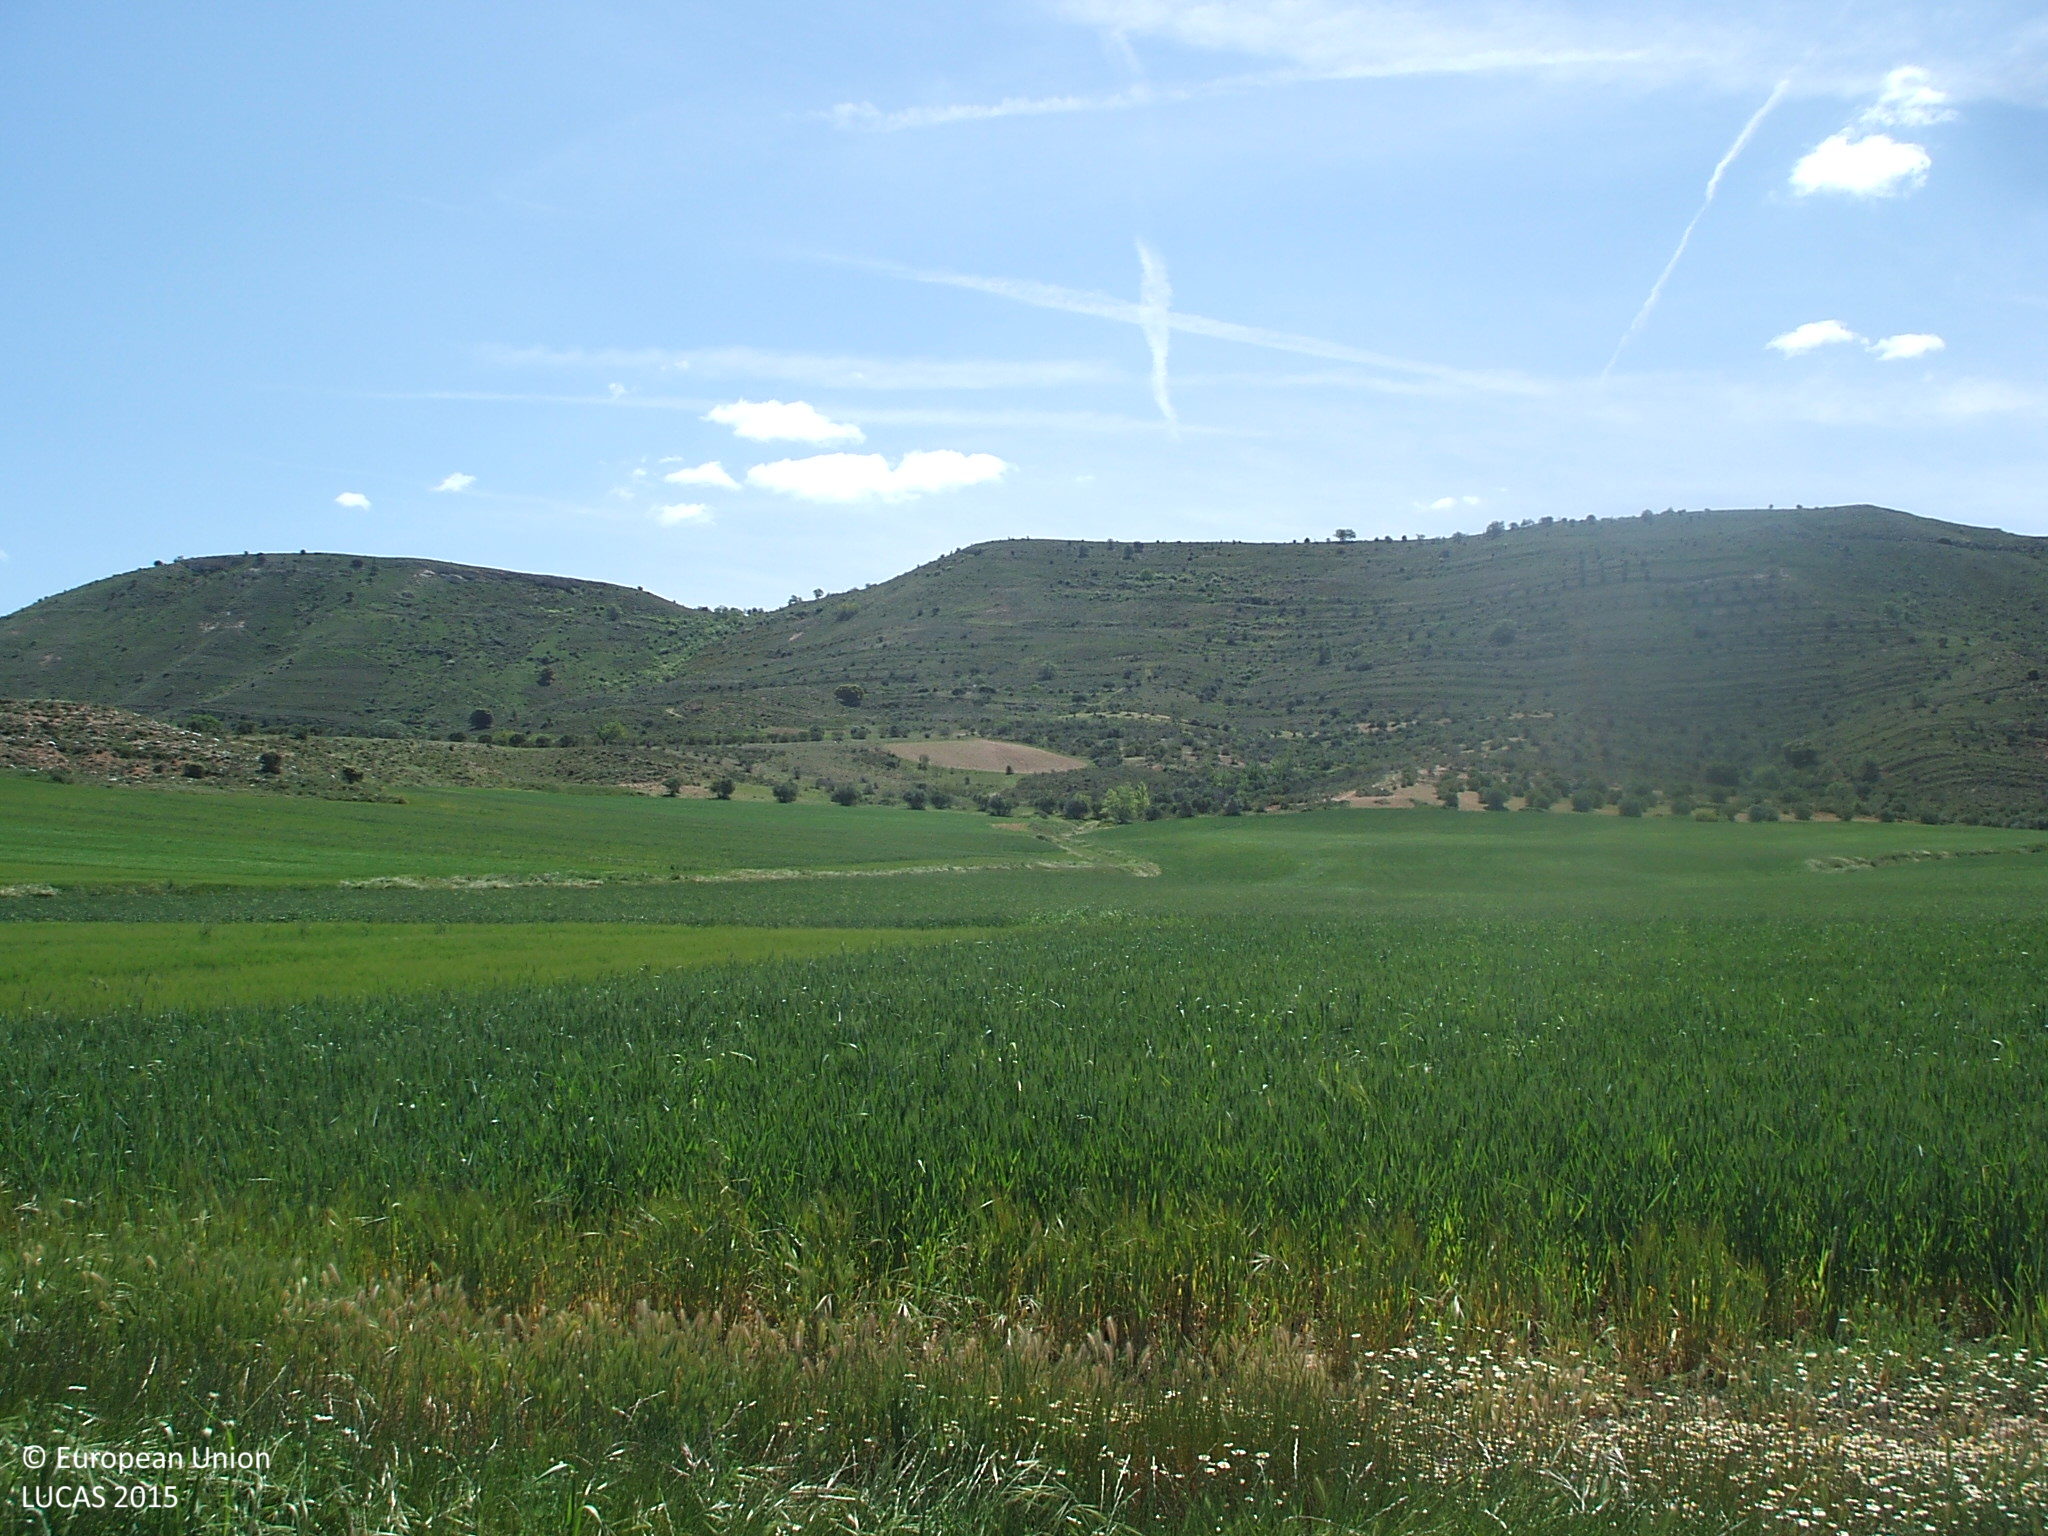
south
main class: Cropland
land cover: Common wheat
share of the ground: > 75 %
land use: Agriculture (excluding fallow land and kitchen gardens)
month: May
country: ES
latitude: 40.8083
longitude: -2.9901
